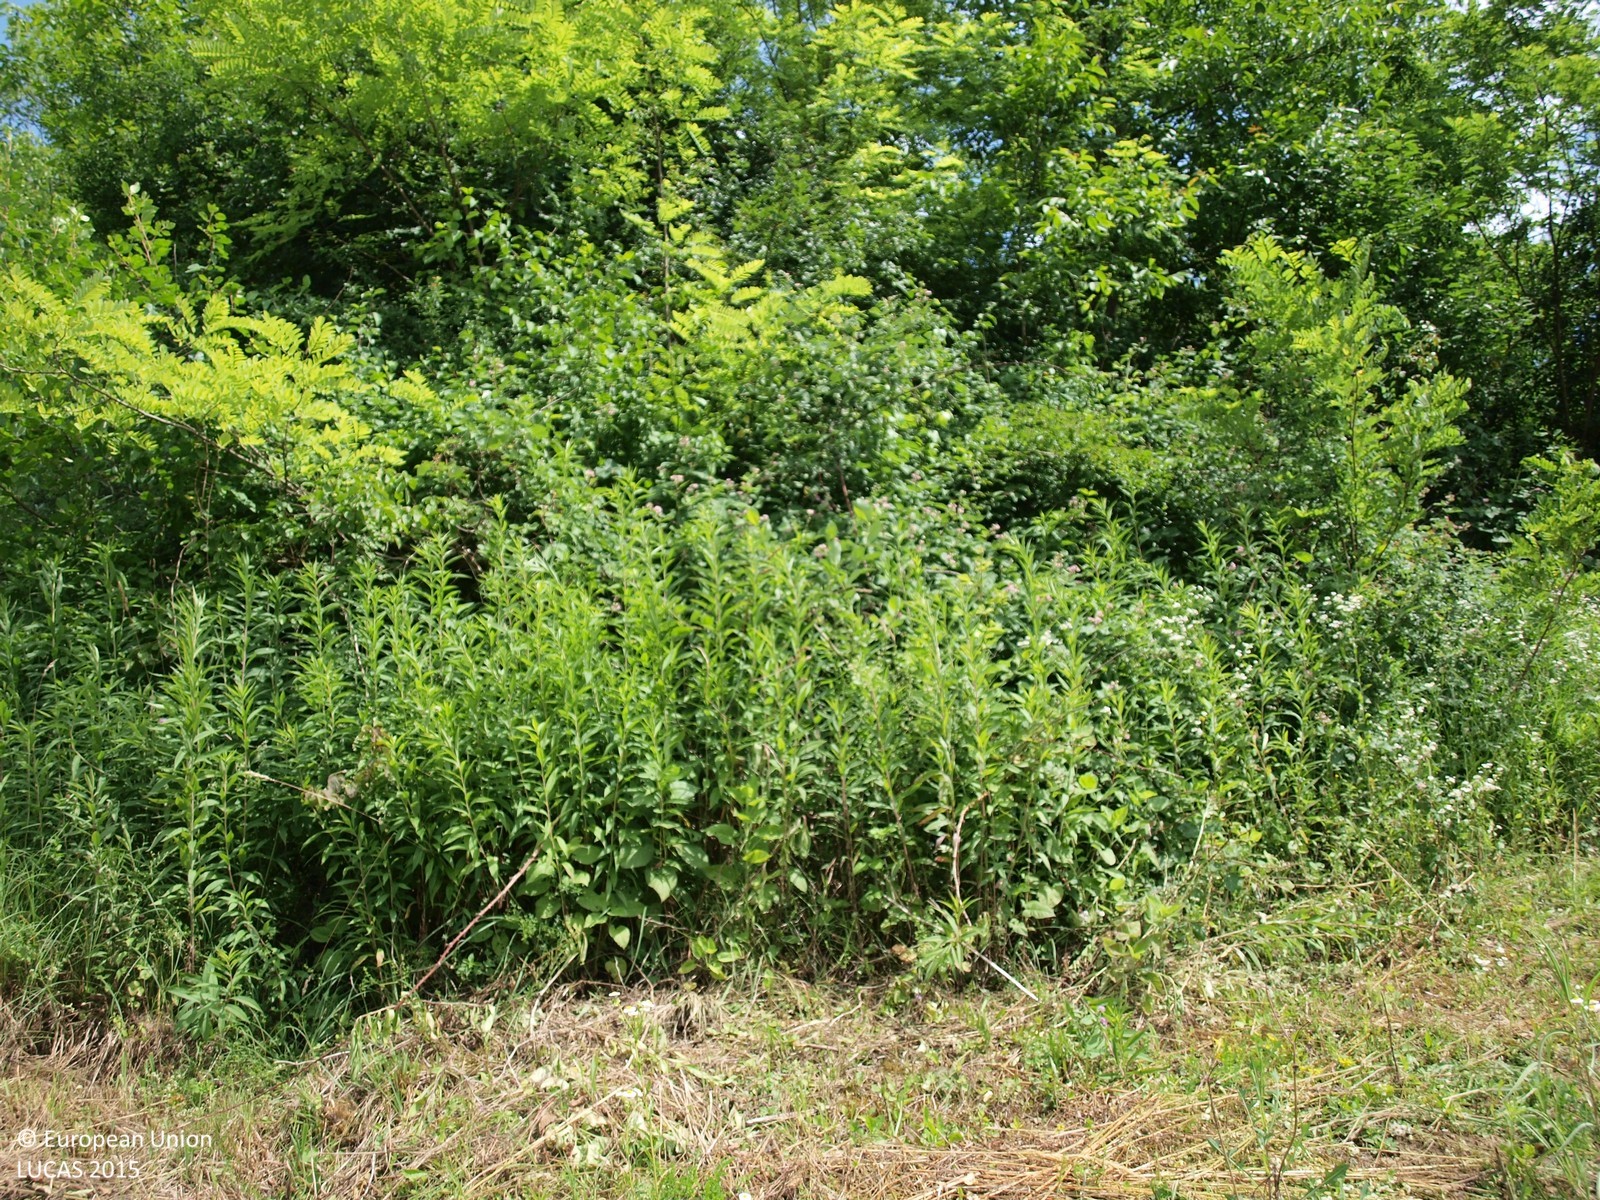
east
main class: Grassland
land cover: Grassland without tree/shrub cover
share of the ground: > 75 %
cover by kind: herbaceous plants 100 %
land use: Agriculture (excluding fallow land and kitchen gardens)
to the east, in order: Grassland without tree/shrub cover; Broadleaved woodland; Tracks; Broadleaved woodland
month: June
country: HR
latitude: 46.1446
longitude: 15.7075
